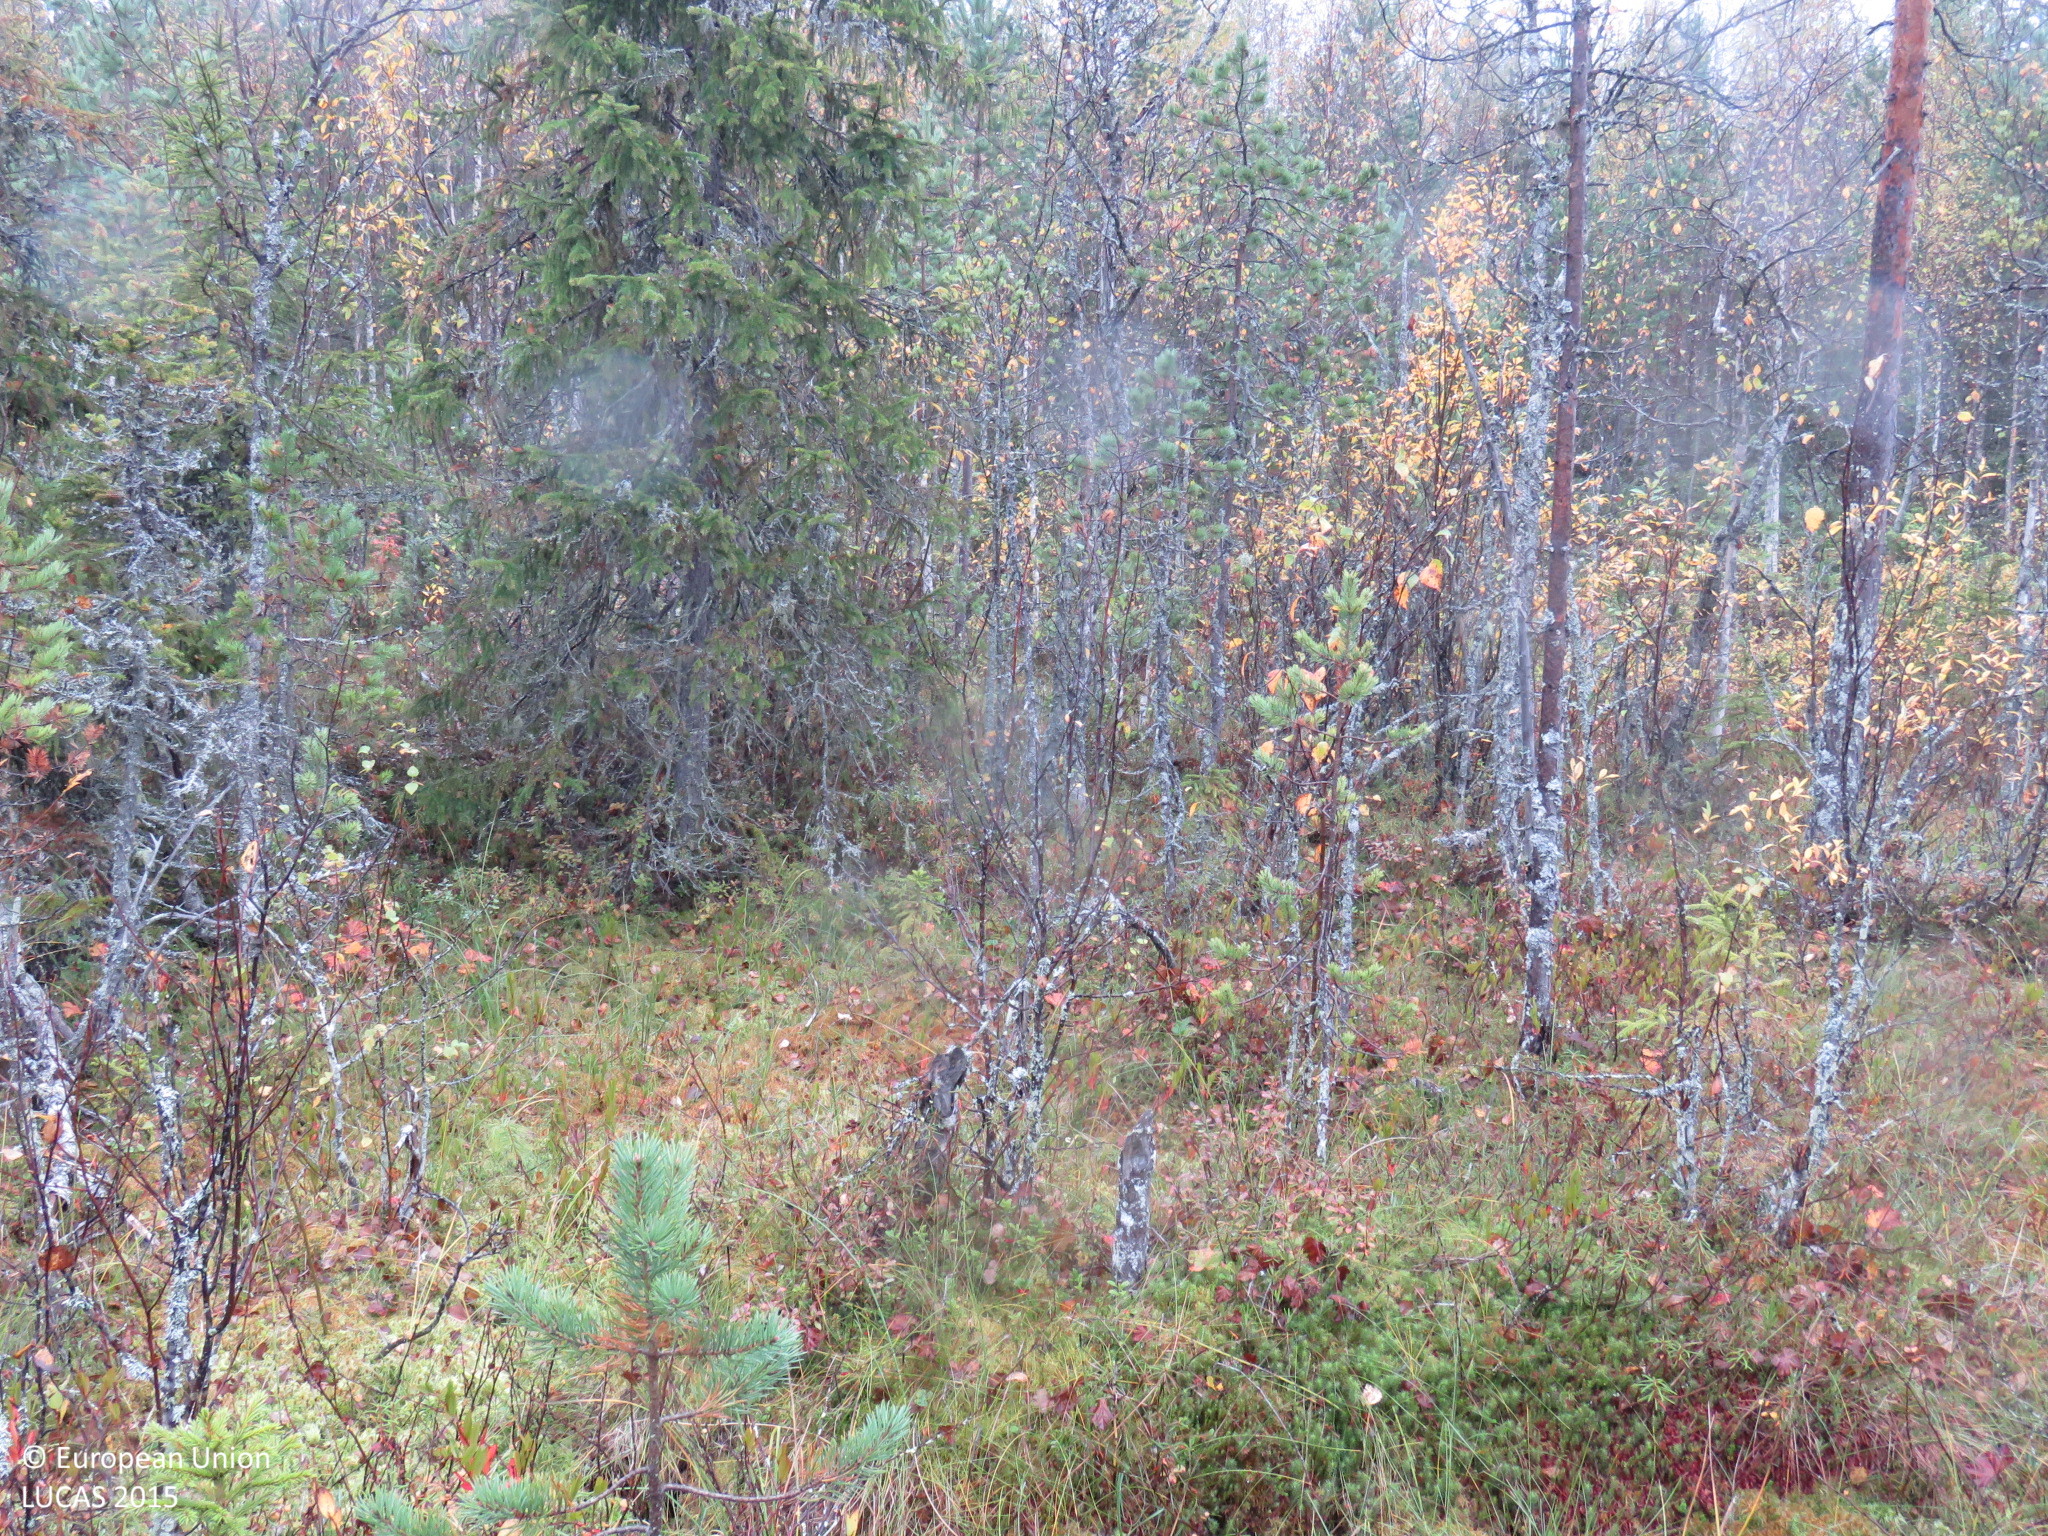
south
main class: Woodland
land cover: Pine dominated coniferous woodland
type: mire and swamp forests
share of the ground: 50 - 75 %
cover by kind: coniferous forest trees 70 %, shrubs 15 %, herbaceous plants 10 %, lichens and mosses 5 %
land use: Semi-natural and natural areas not in use
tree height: < 5 m
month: September
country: FI
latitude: 64.8653
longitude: 26.6351
